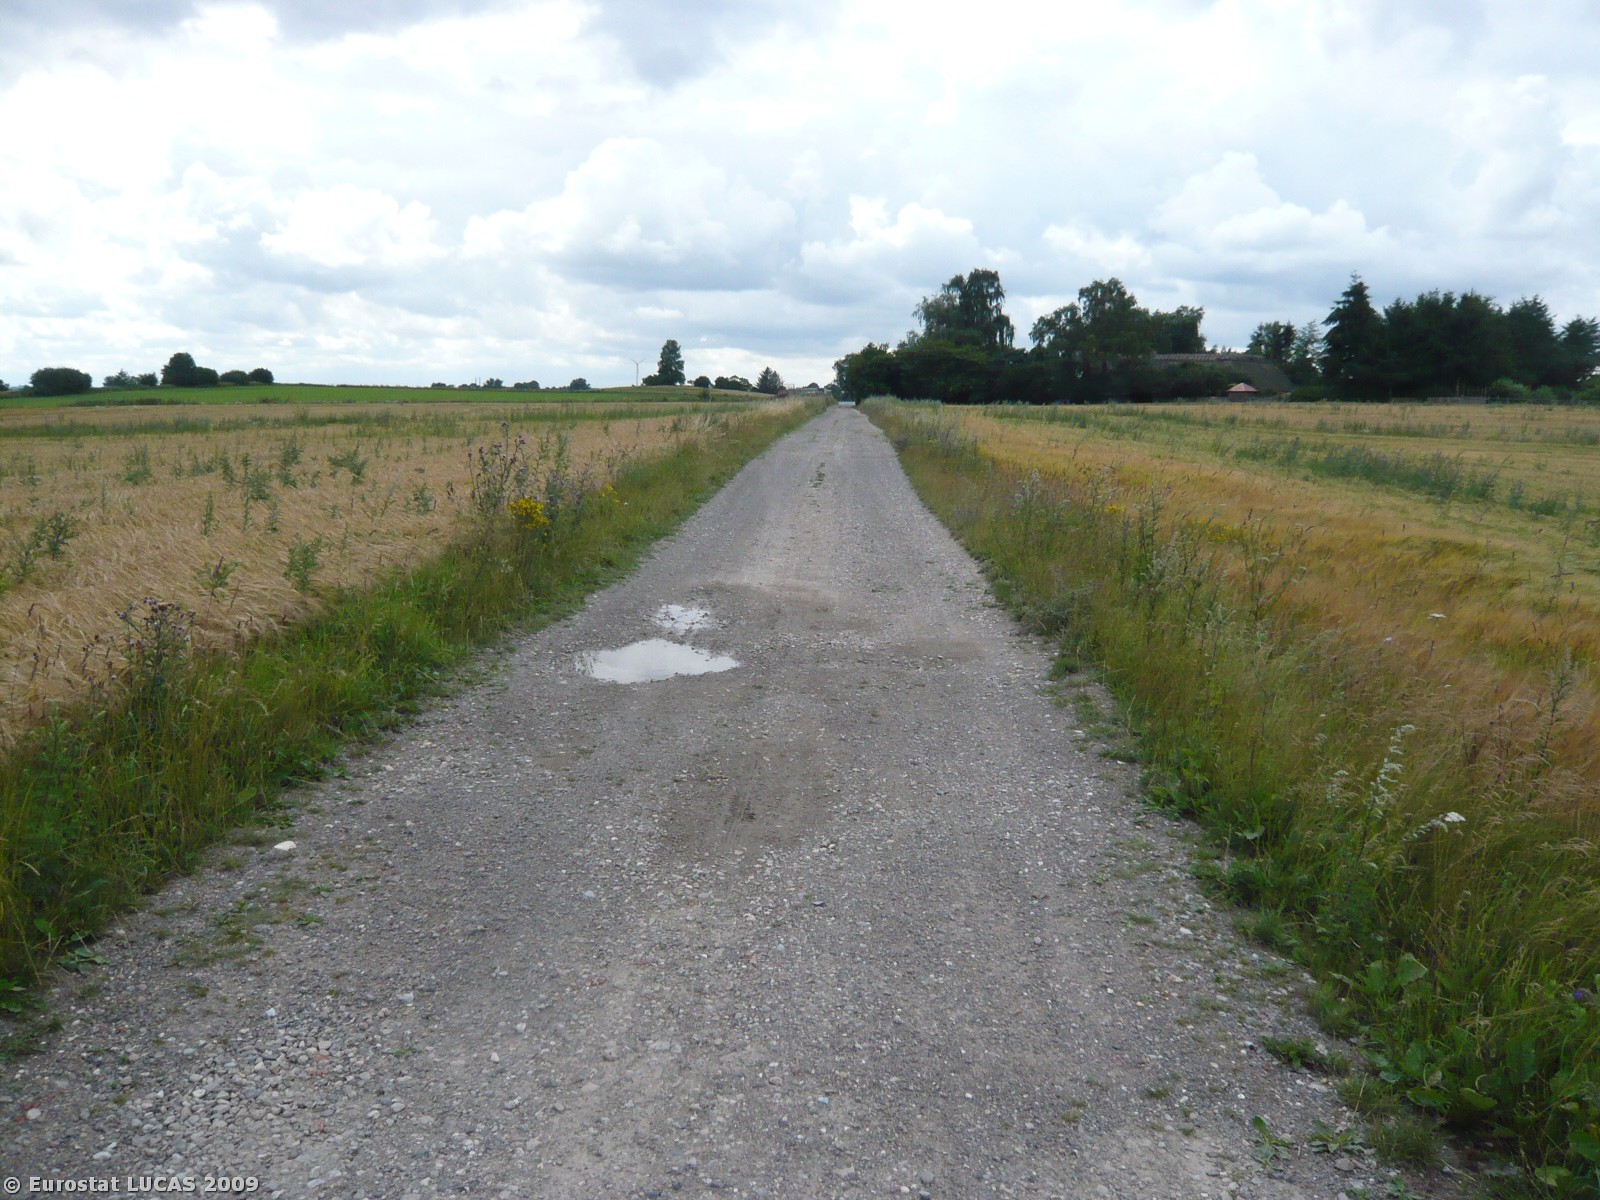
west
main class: Cropland
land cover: Barley
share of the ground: > 75 %
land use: Agriculture (excluding fallow land and kitchen gardens)
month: July
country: DK
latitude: 55.5082
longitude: 11.9143
